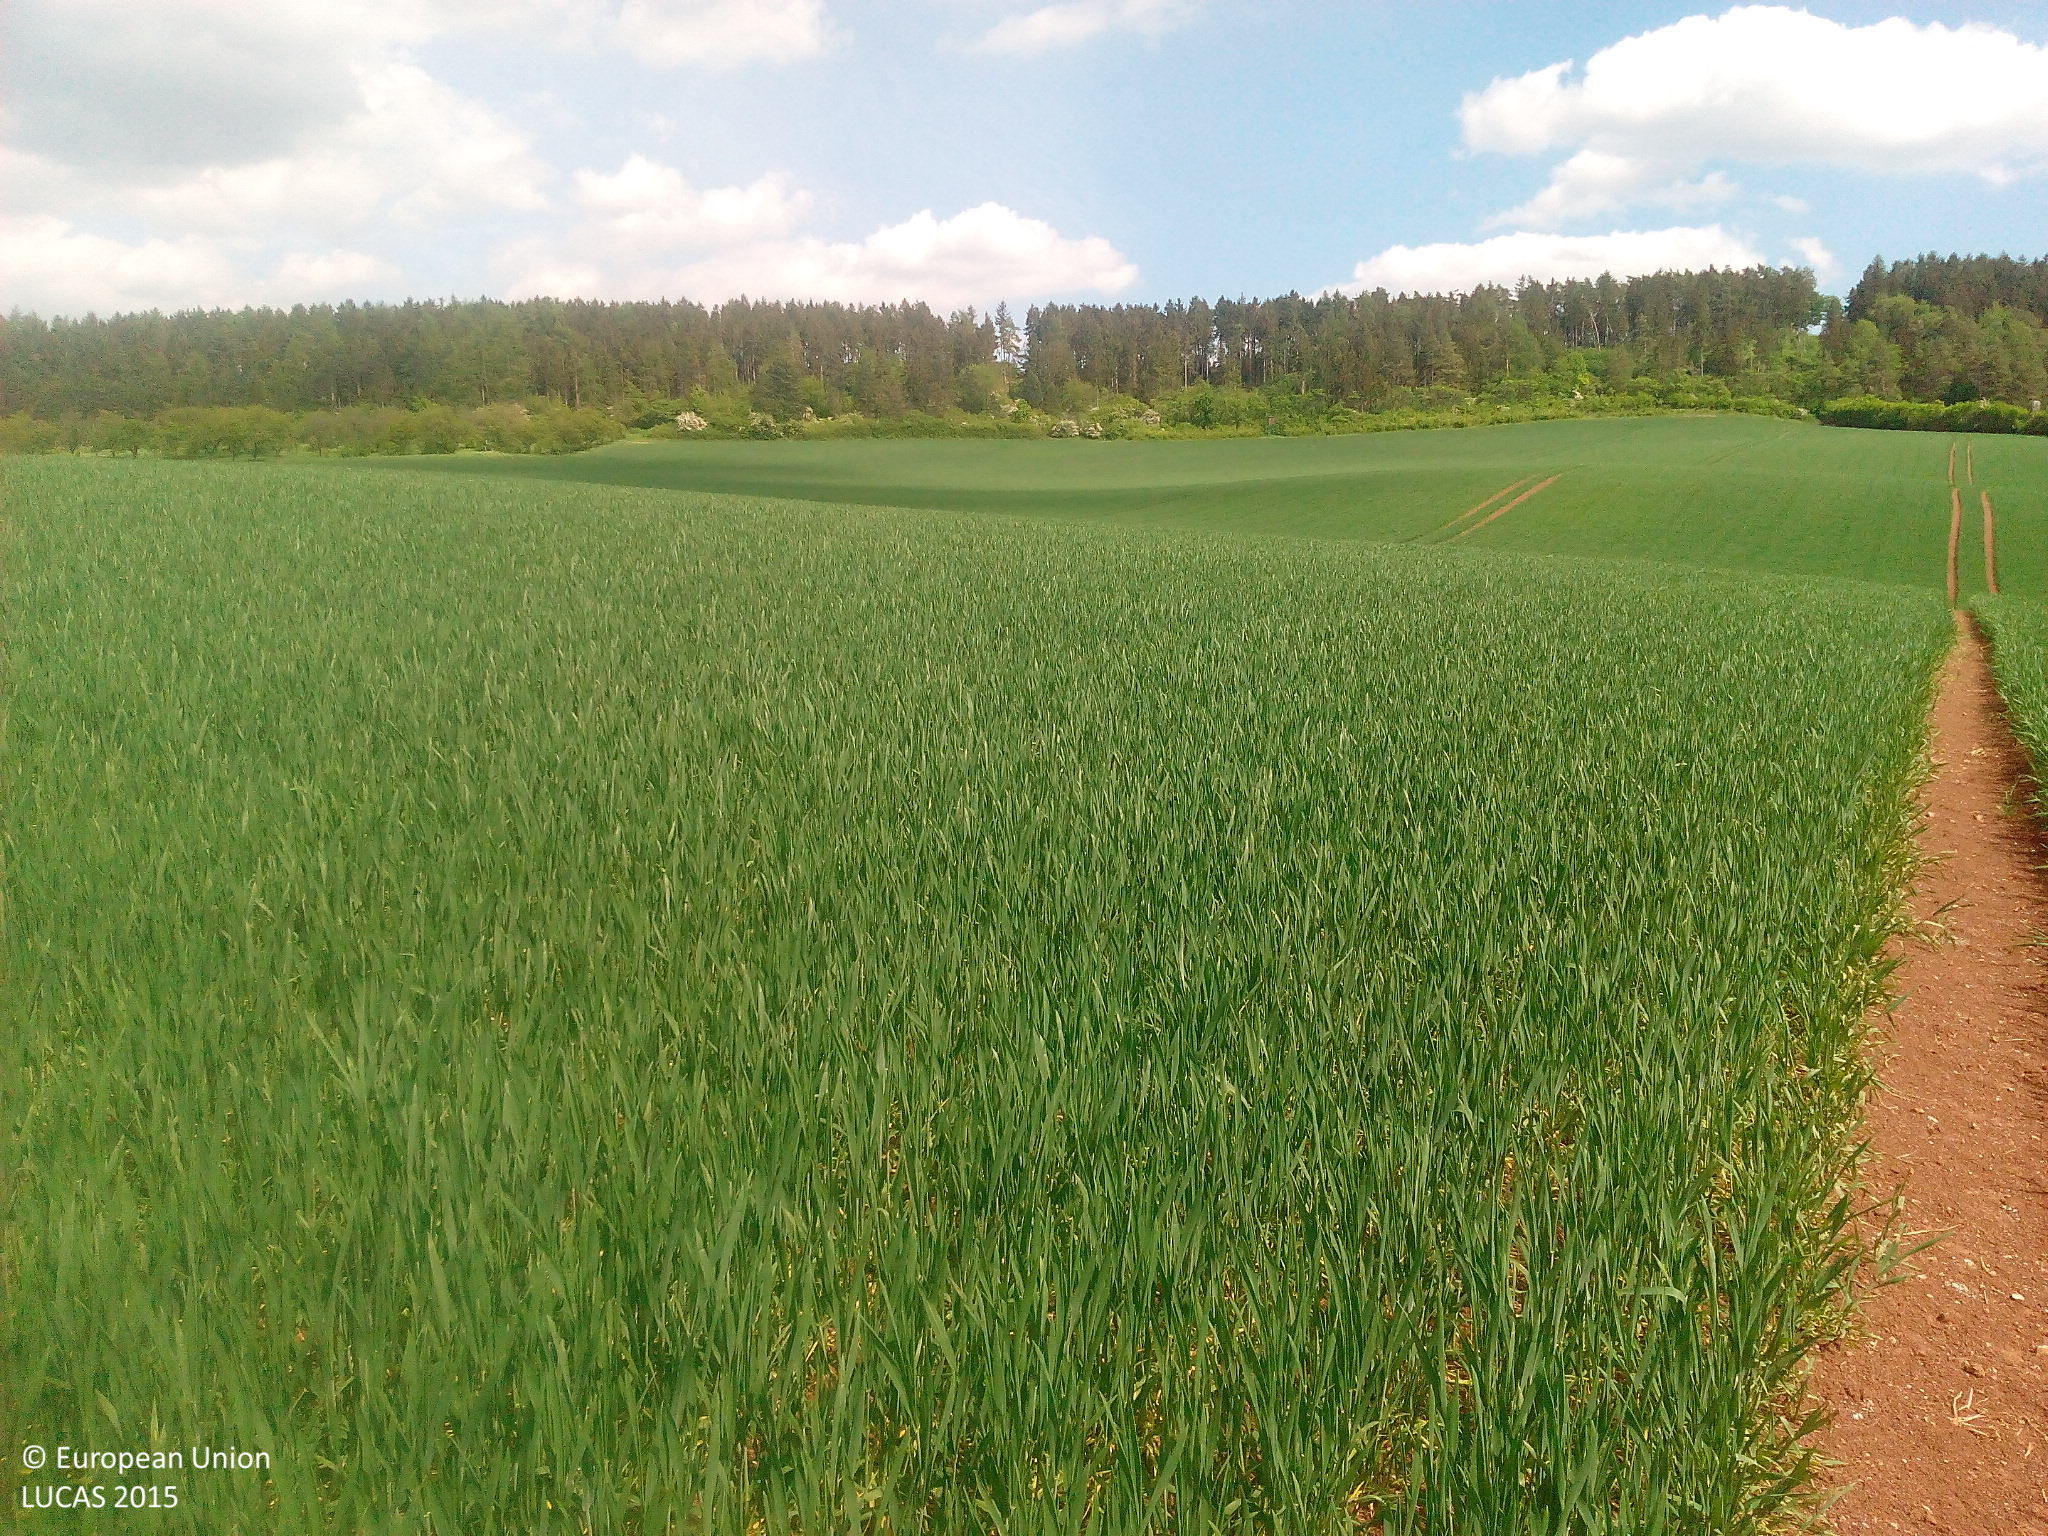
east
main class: Cropland
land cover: Triticale
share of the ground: > 75 %
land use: Agriculture (excluding fallow land and kitchen gardens)
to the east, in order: Triticale
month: May
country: DE
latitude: 51.3708
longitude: 9.9569
